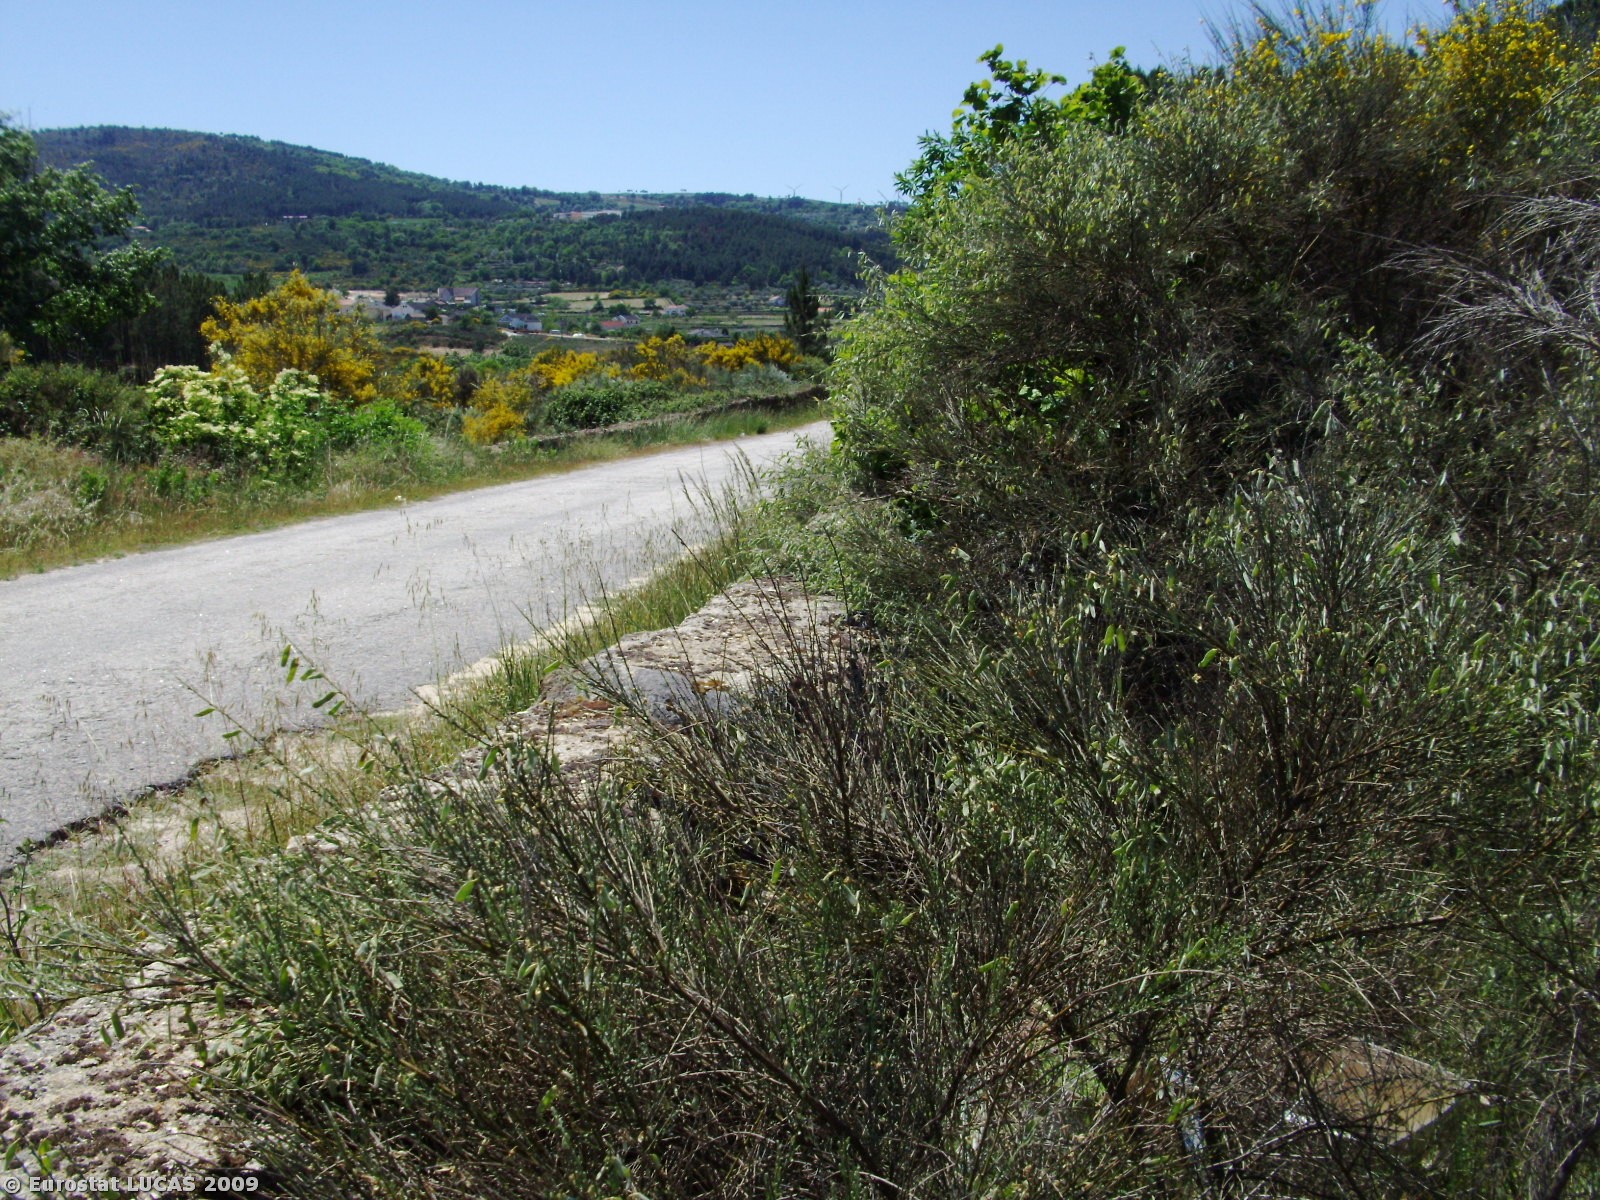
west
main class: Shrubland
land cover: Shrubland without tree cover
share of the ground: > 75 %
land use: Unused
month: May
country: PT
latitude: 40.9733
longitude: -7.5780
